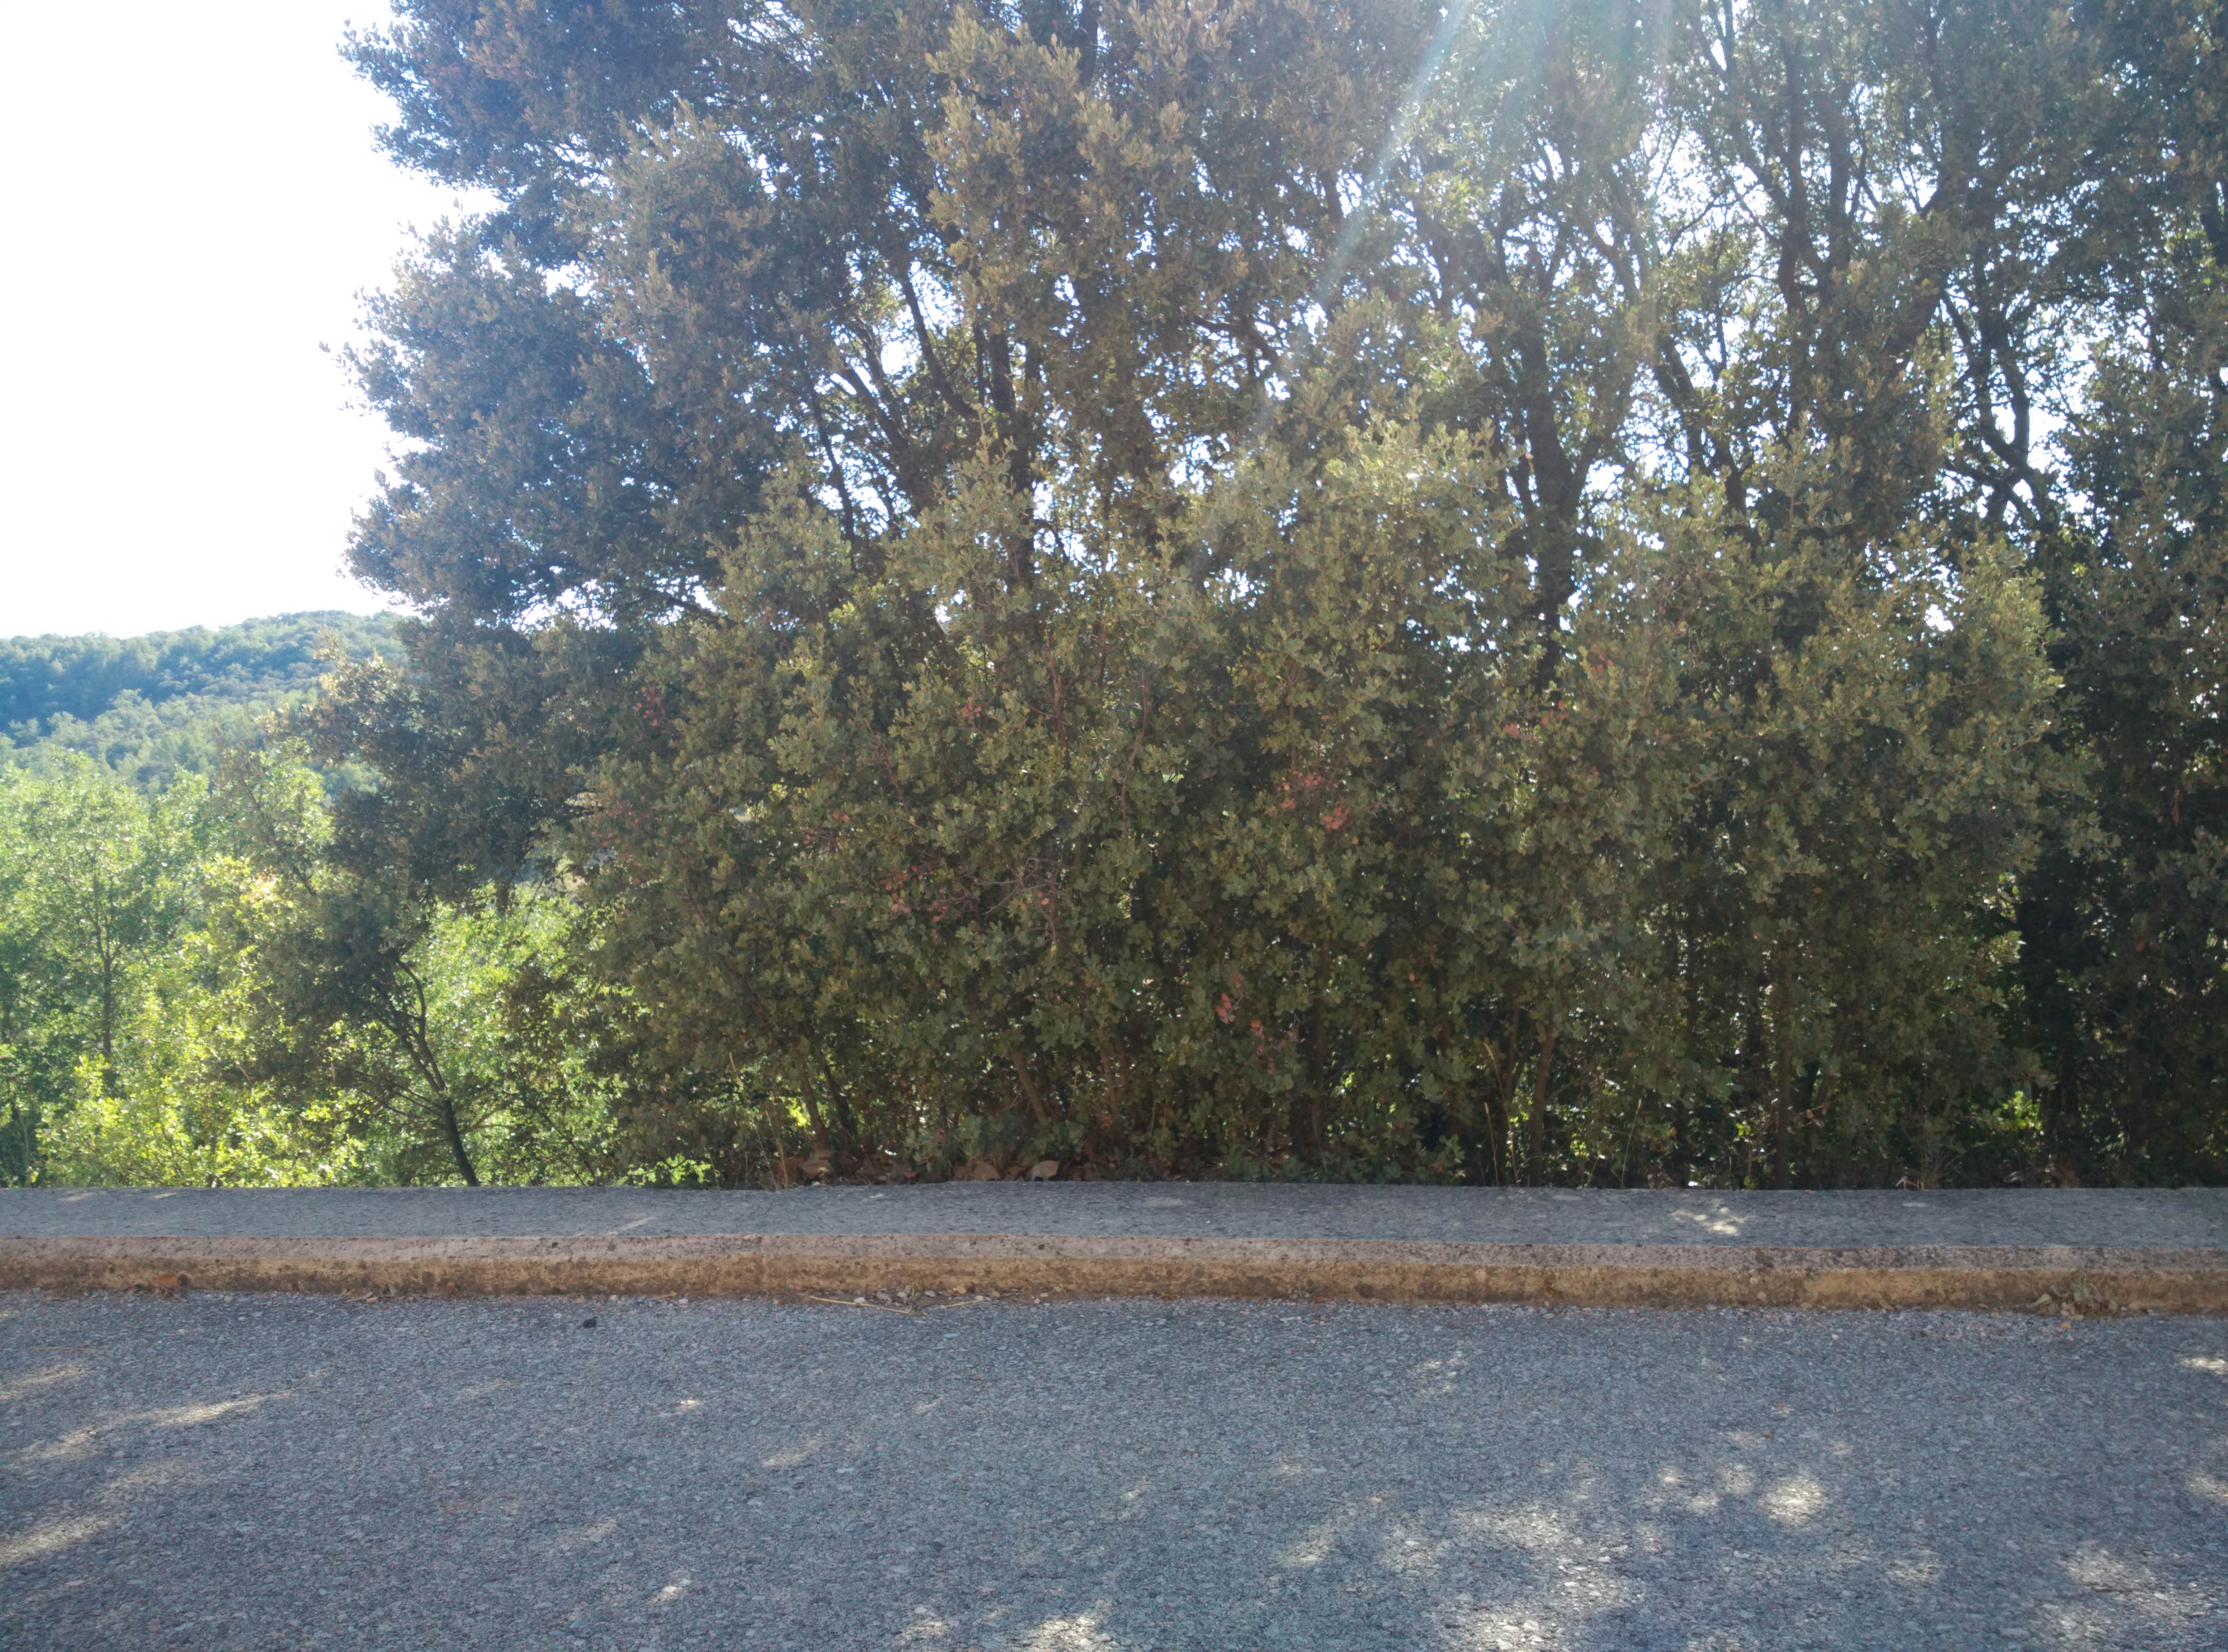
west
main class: Shrubland
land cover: Shrubland without tree cover
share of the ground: 50 - 75 %
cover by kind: shrubs 50 %, unconsolidated bare surface 40 %, herbaceous plants 10 %
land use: Semi-natural and natural areas not in use
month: July
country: ES
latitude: 40.6968
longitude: -2.5838
